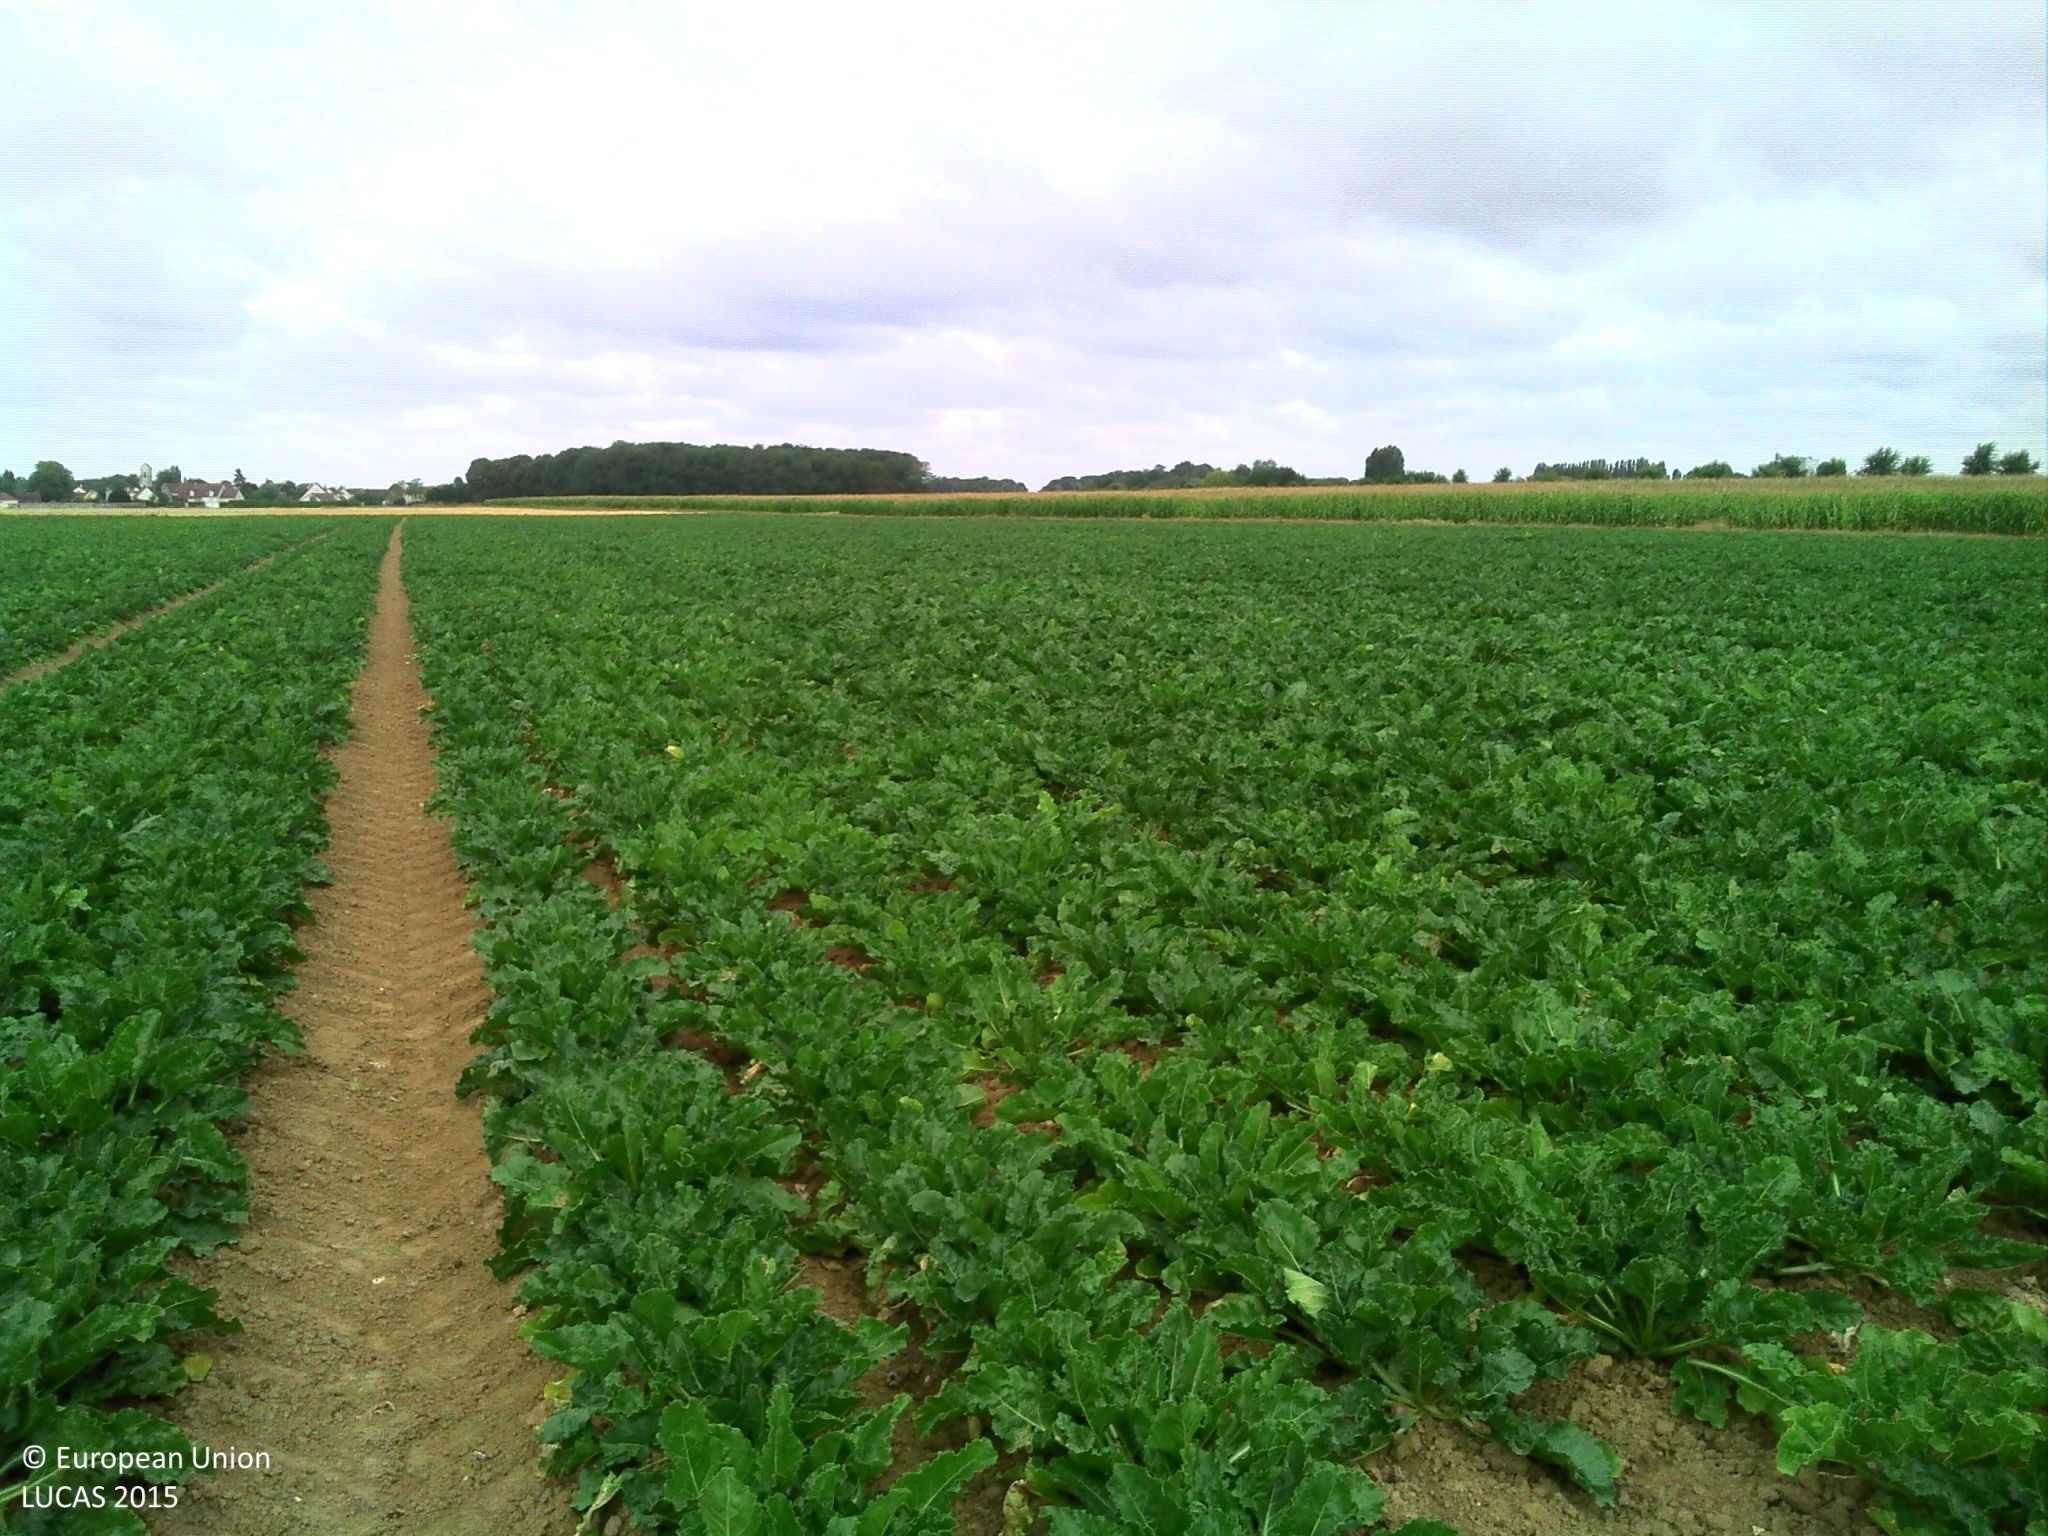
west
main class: Cropland
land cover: Sugar beet
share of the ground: > 75 %
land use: Agriculture (excluding fallow land and kitchen gardens)
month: July
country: FR
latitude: 48.6302
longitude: 2.6766
